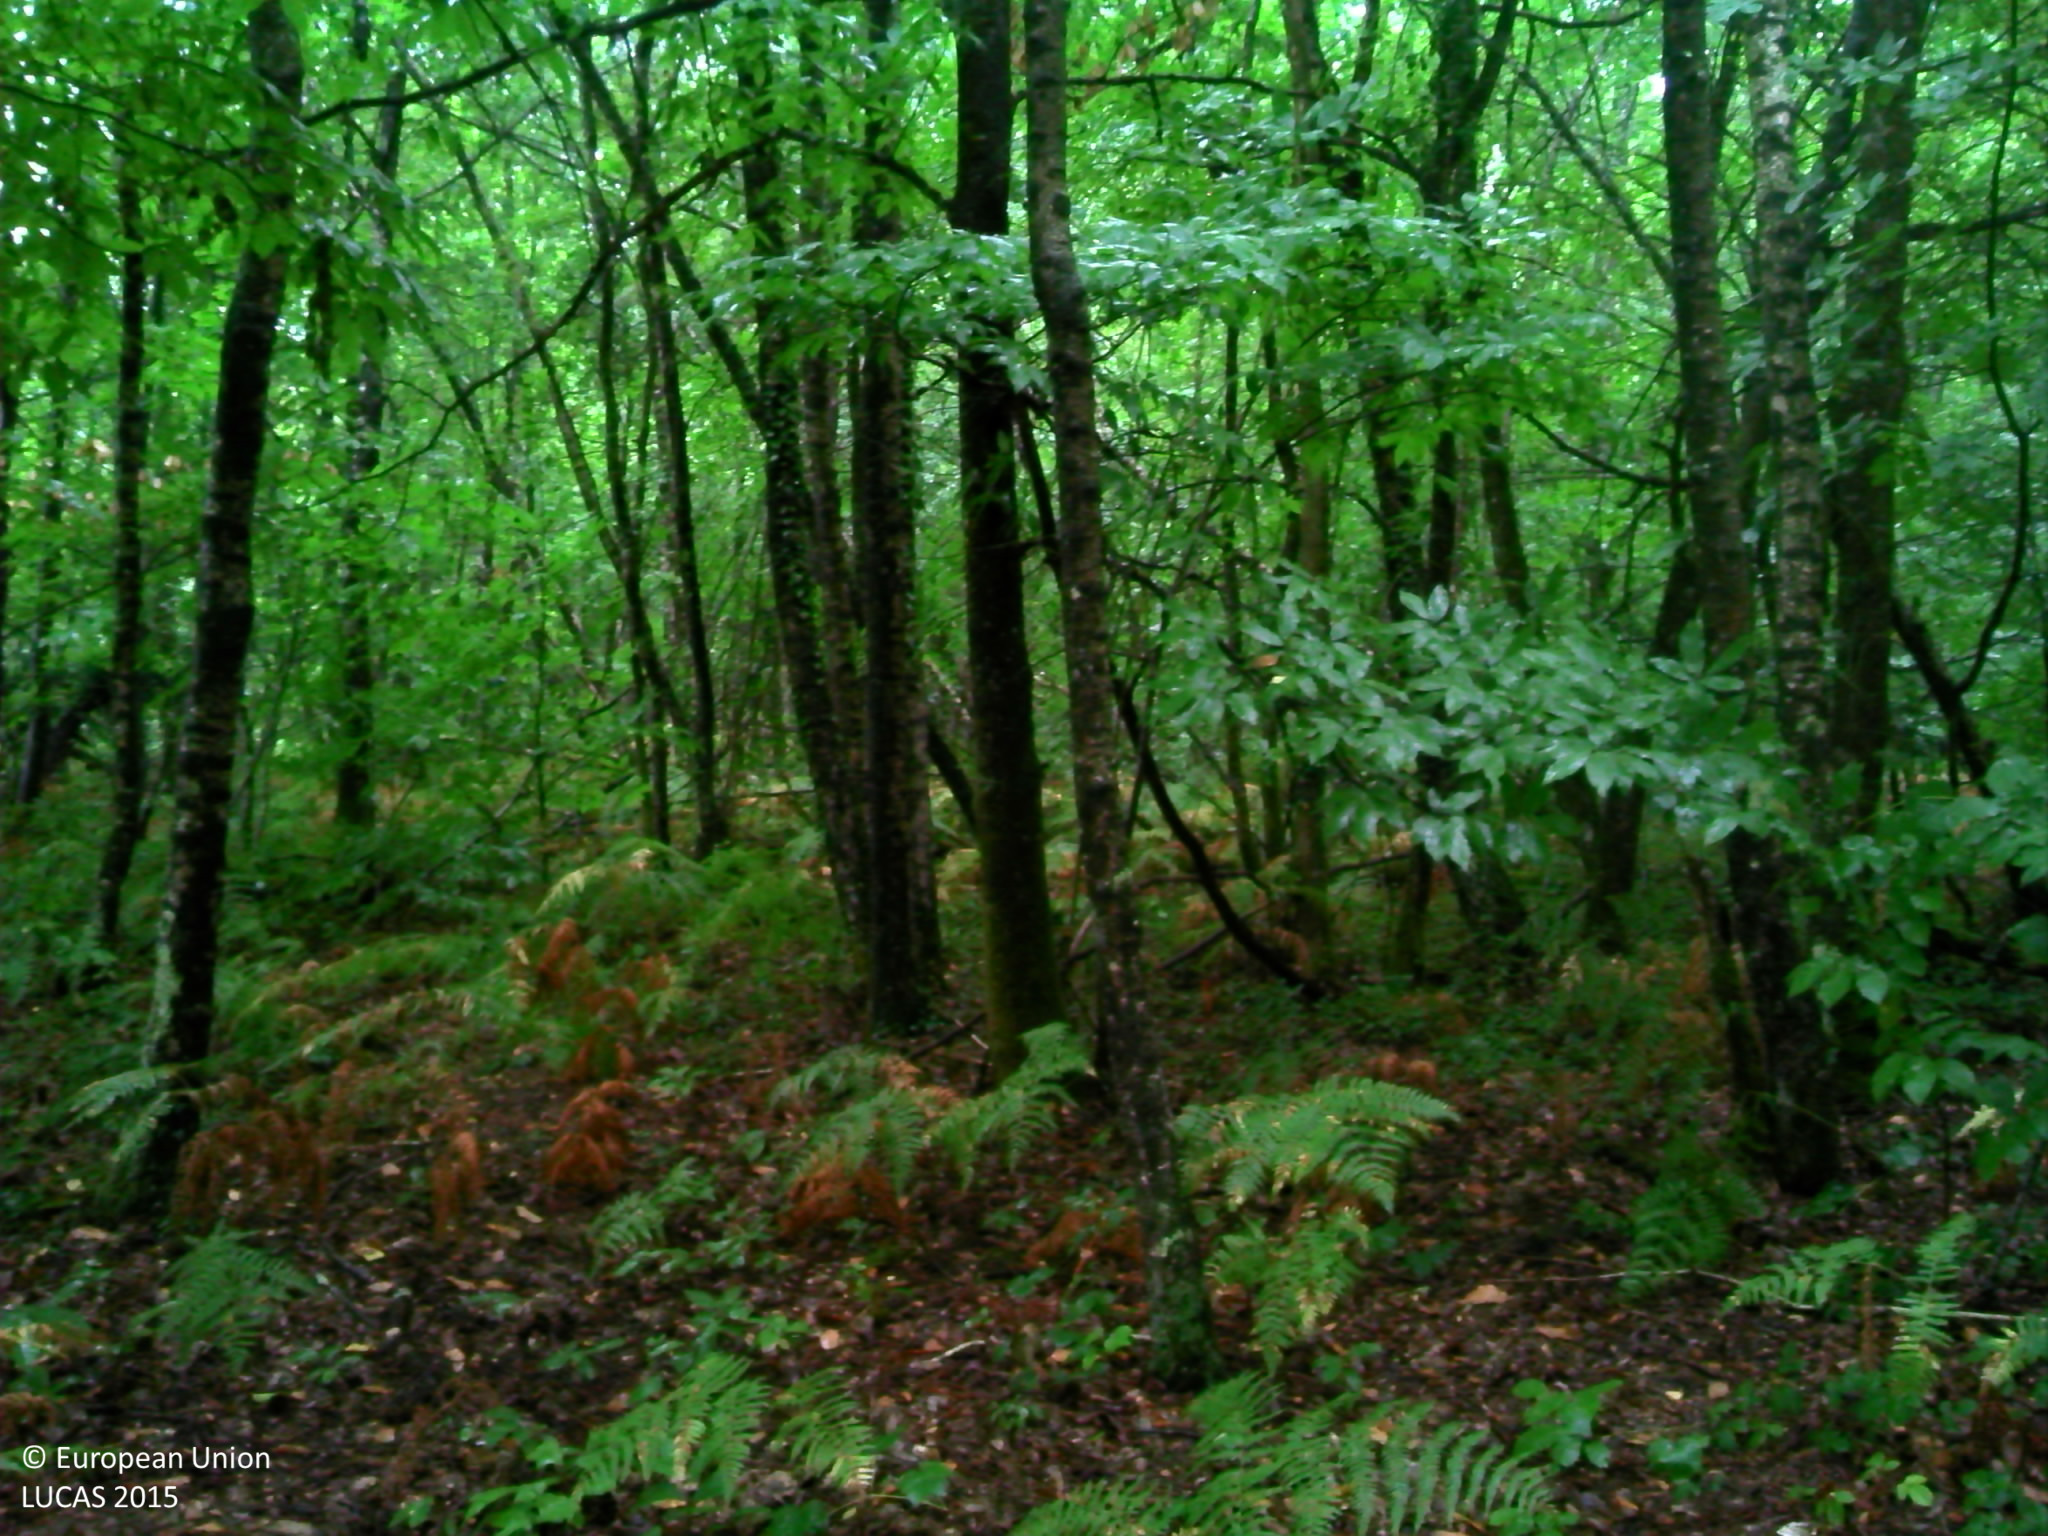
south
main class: Woodland
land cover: Broadleaved woodland
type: thermophilous deciduous forest
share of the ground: > 75 %
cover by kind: broadleaved forest trees 75 %, herbaceous plants 10 %, shrubs 5 %, lichens and mosses 5 %, consolidated bare surface 5 %
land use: Forestry
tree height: > 5 m
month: August
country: FR
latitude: 45.4684
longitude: 0.6383
